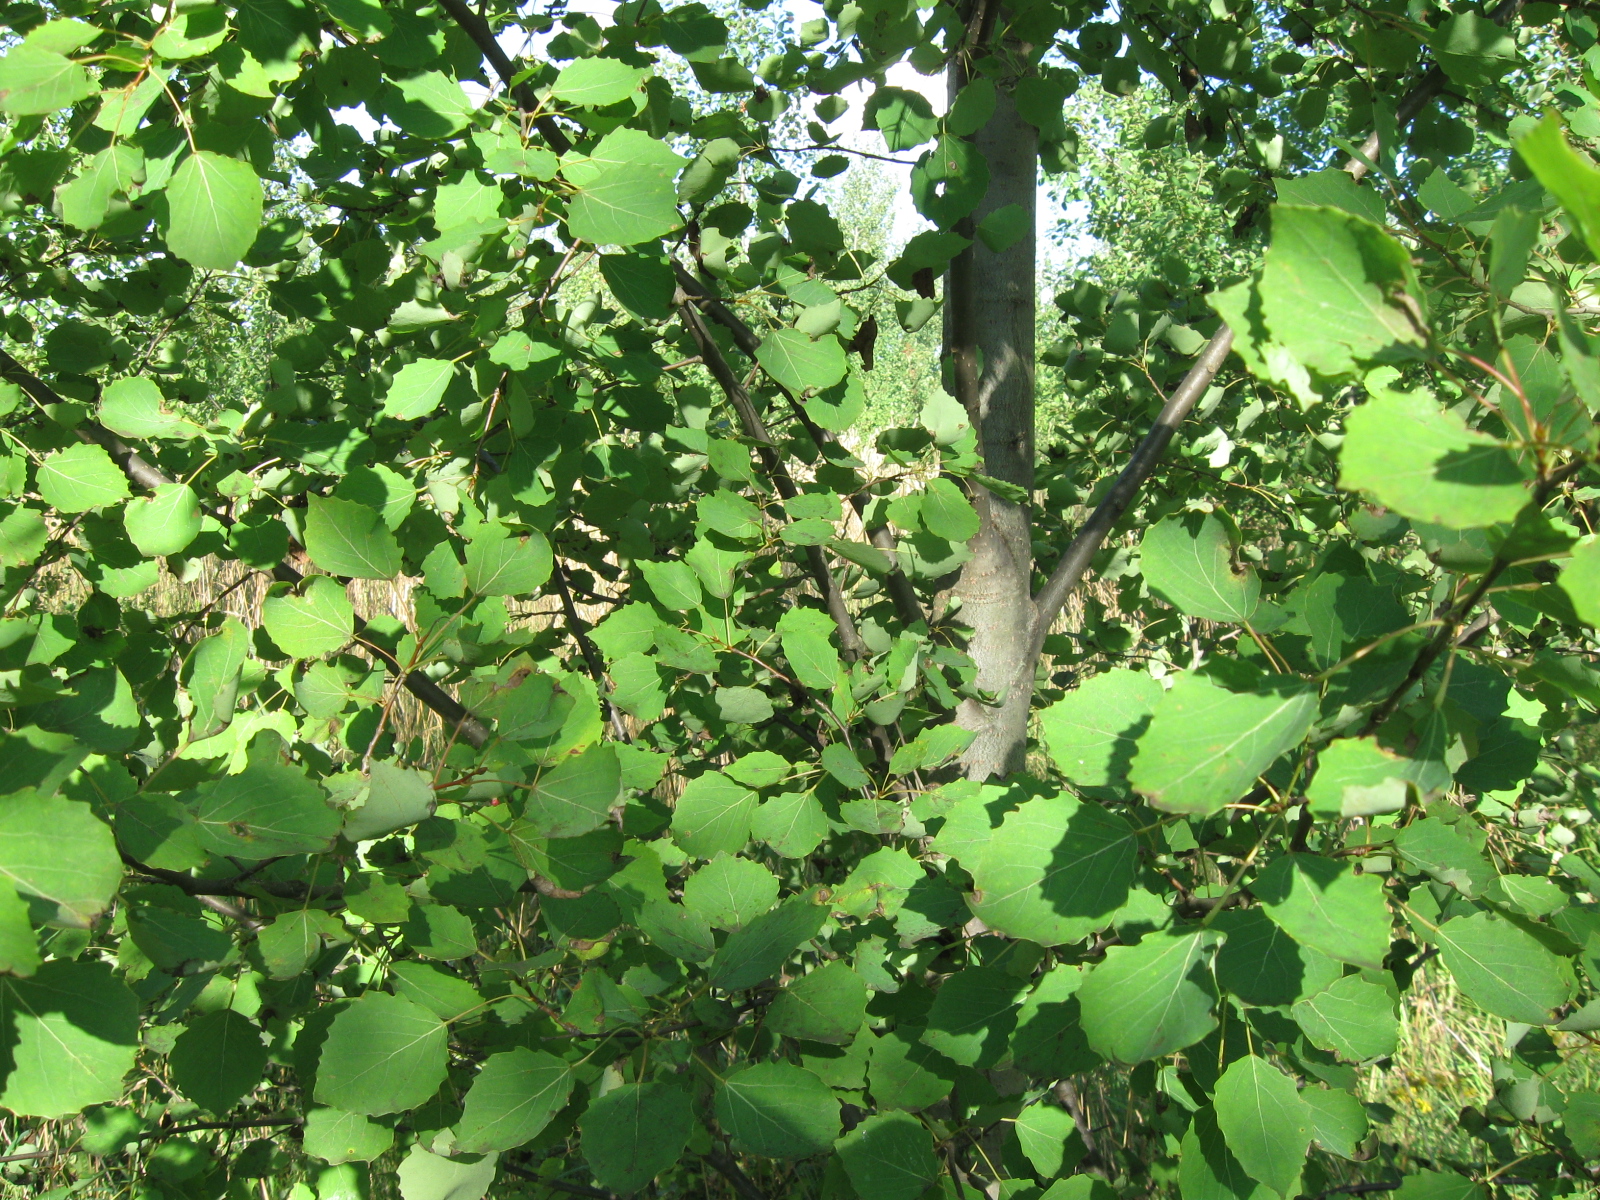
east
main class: Woodland
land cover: Broadleaved woodland
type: non-riverine alder, birch or aspen forest
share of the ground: 50 - 75 %
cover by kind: broadleaved forest trees 55 %, herbaceous plants 45 %
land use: Forestry
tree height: < 5 m
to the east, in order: Broadleaved woodland; Electric lines; Spontaneously vegetated surfaces; Paved roads, cycling and walking lanes; Spontaneously vegetated surfaces; Broadleaved woodland; Spontaneously vegetated surfaces; Broadleaved woodland
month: July
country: LT
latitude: 54.3053
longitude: 23.4675
